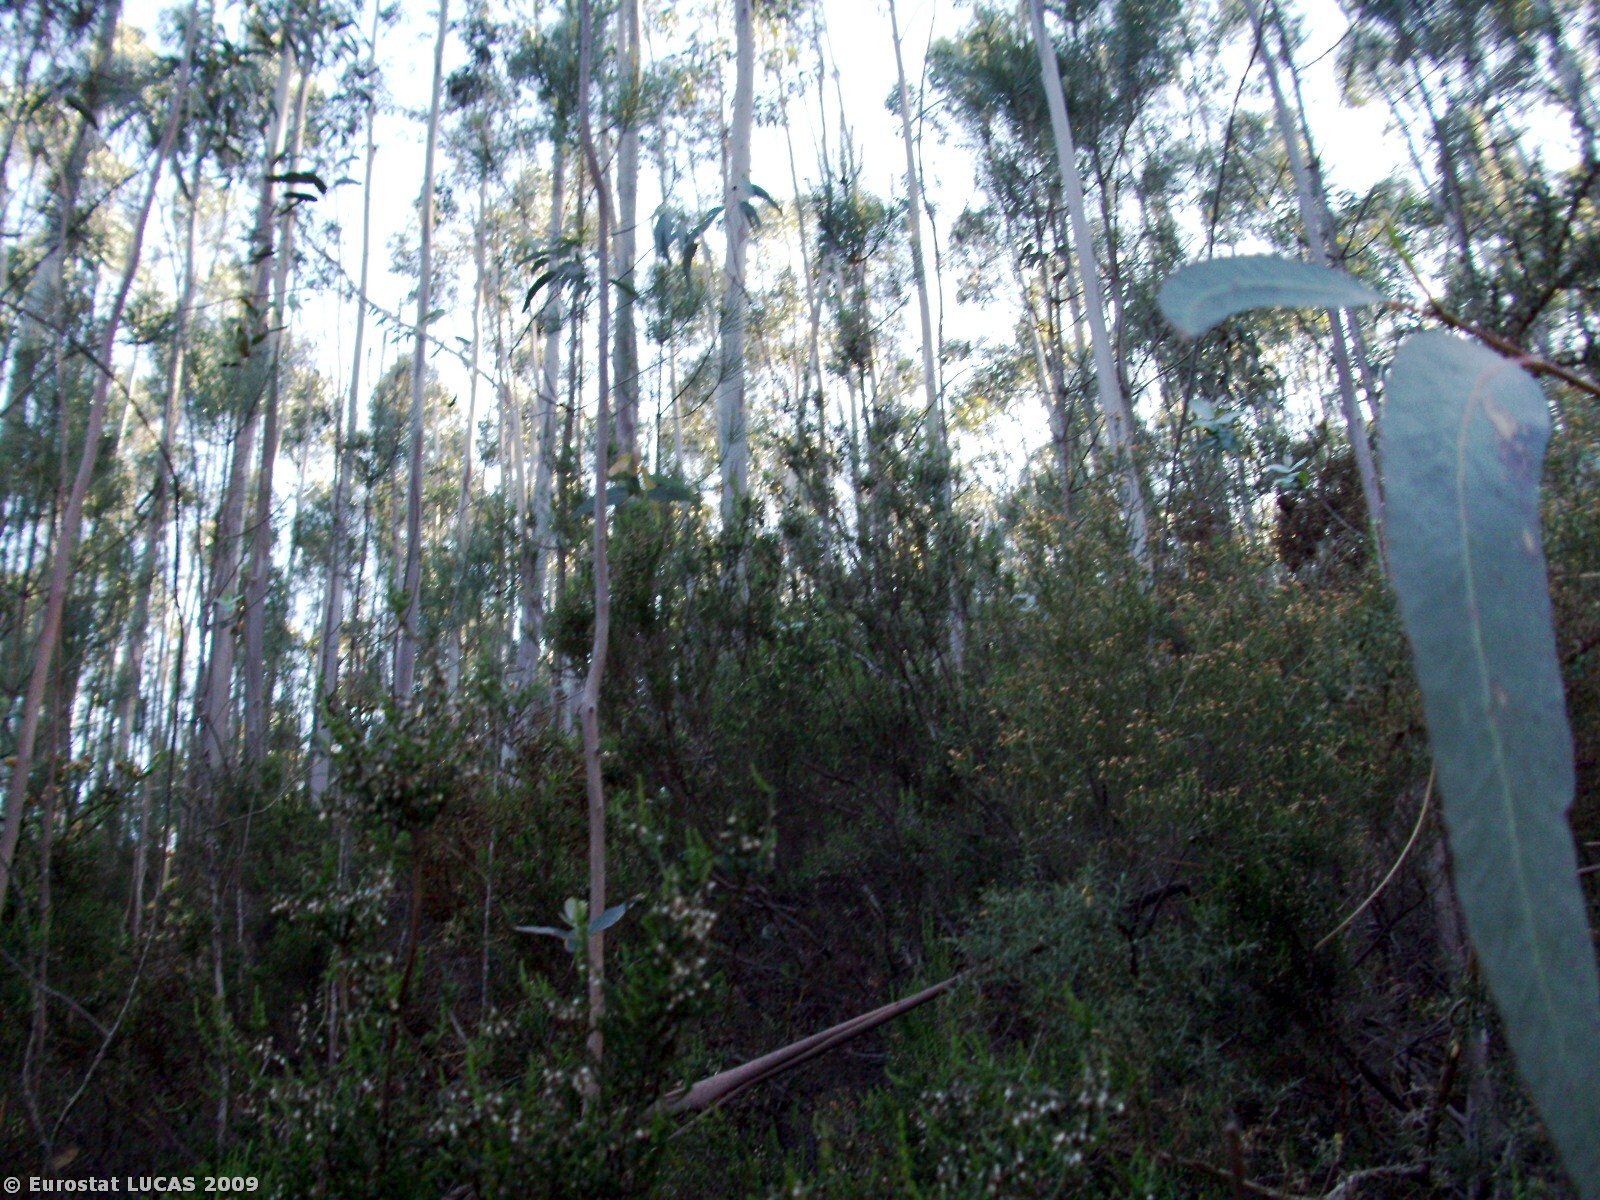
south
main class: Woodland
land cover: Broadleaved woodland
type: plantations and self-sown exotic forest
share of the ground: > 75 %
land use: Forestry
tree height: > 5 m
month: May
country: PT
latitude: 40.7408
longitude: -8.4366
